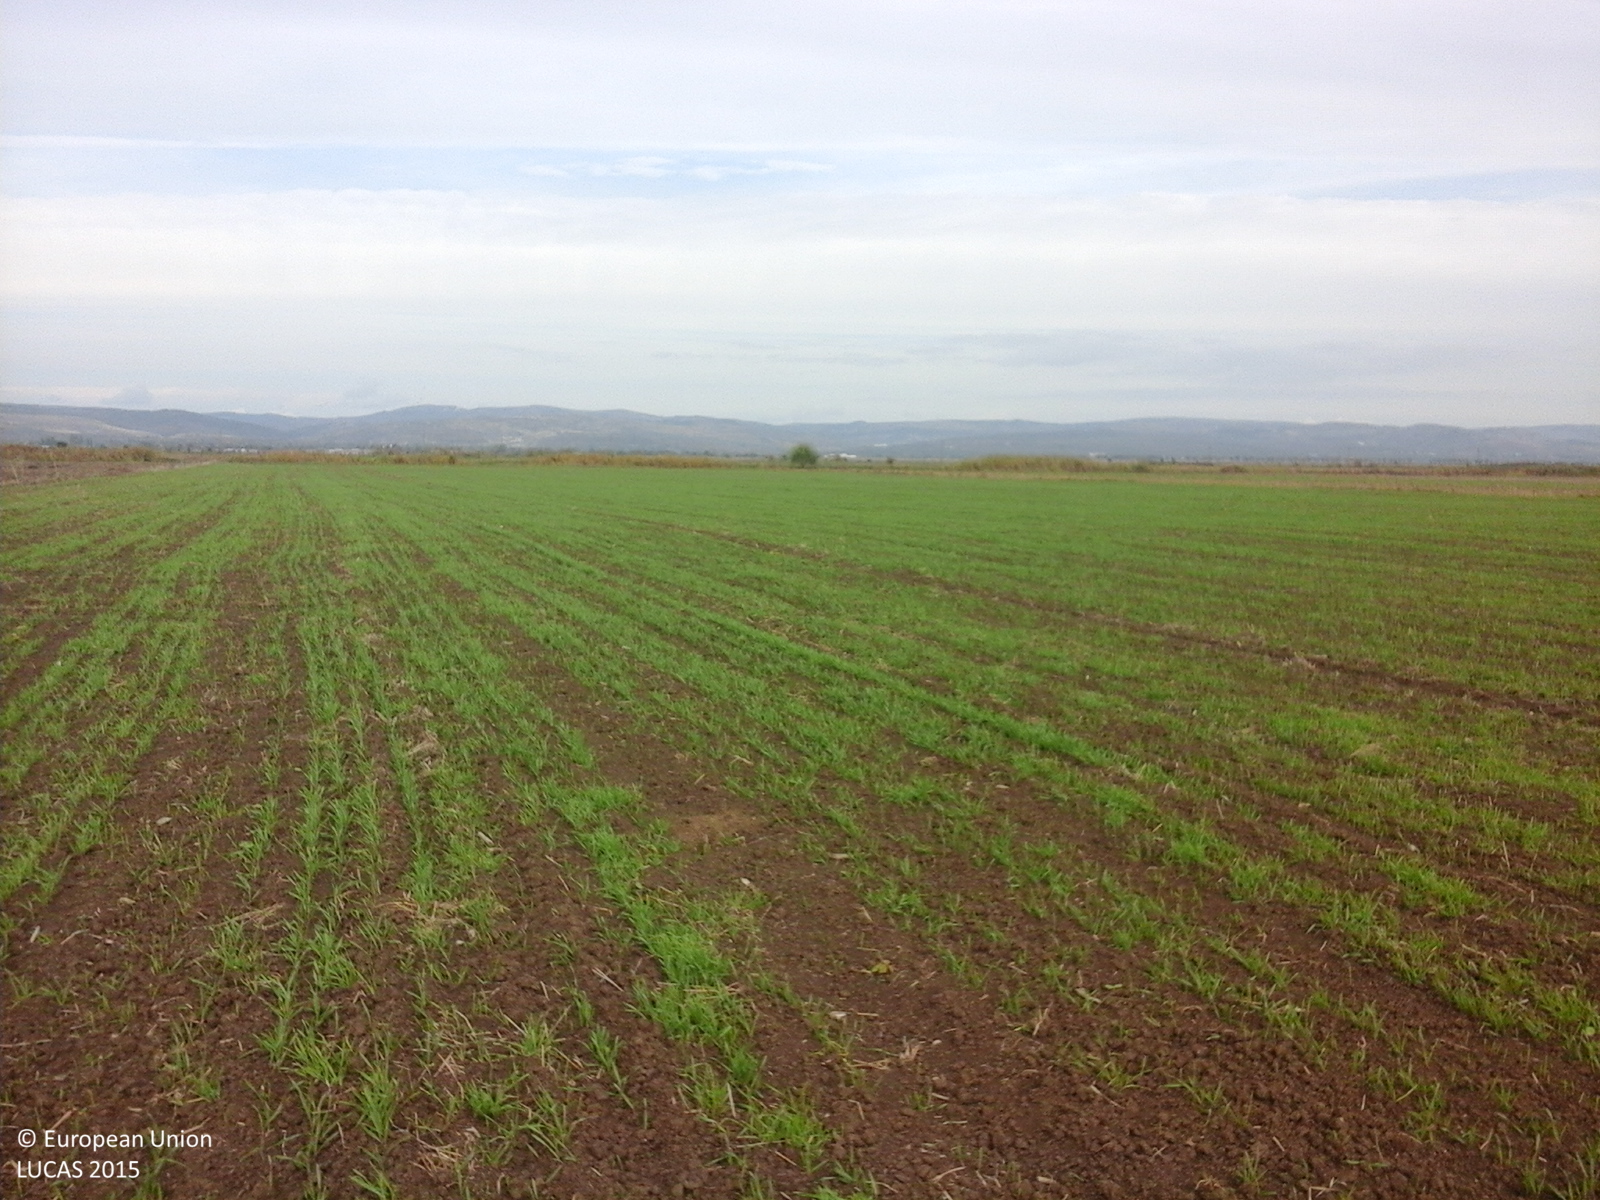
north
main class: Cropland
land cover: Common wheat
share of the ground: 50 - 75 %
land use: Agriculture (excluding fallow land and kitchen gardens)
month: October
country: RO
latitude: 44.9842
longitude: 26.3892
